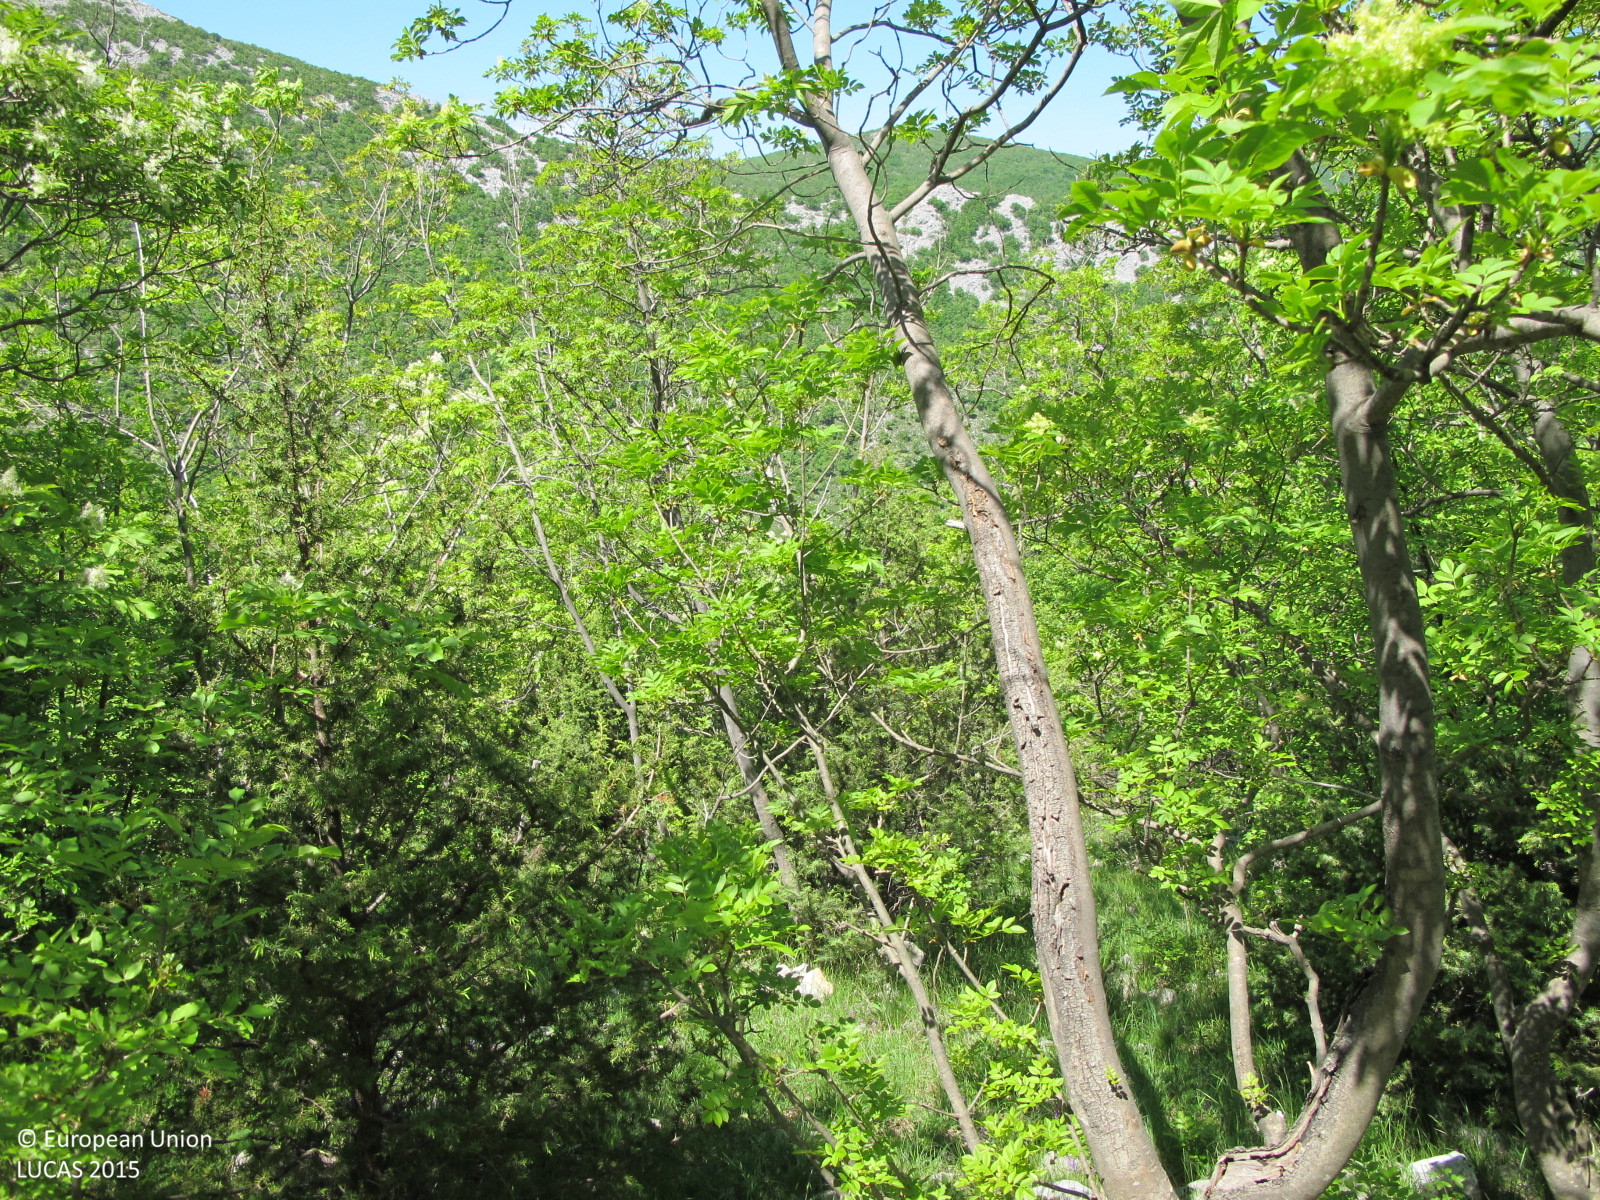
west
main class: Woodland
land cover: Broadleaved woodland
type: mesophytic deciduous forest
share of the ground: > 75 %
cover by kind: broadleaved forest trees 70 %, coniferous forest trees 10 %, shrubs 10 %, herbaceous plants 5 %, consolidated bare surface 5 %
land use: Forestry
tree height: < 5 m
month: May
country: HR
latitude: 45.1587
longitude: 14.8414
